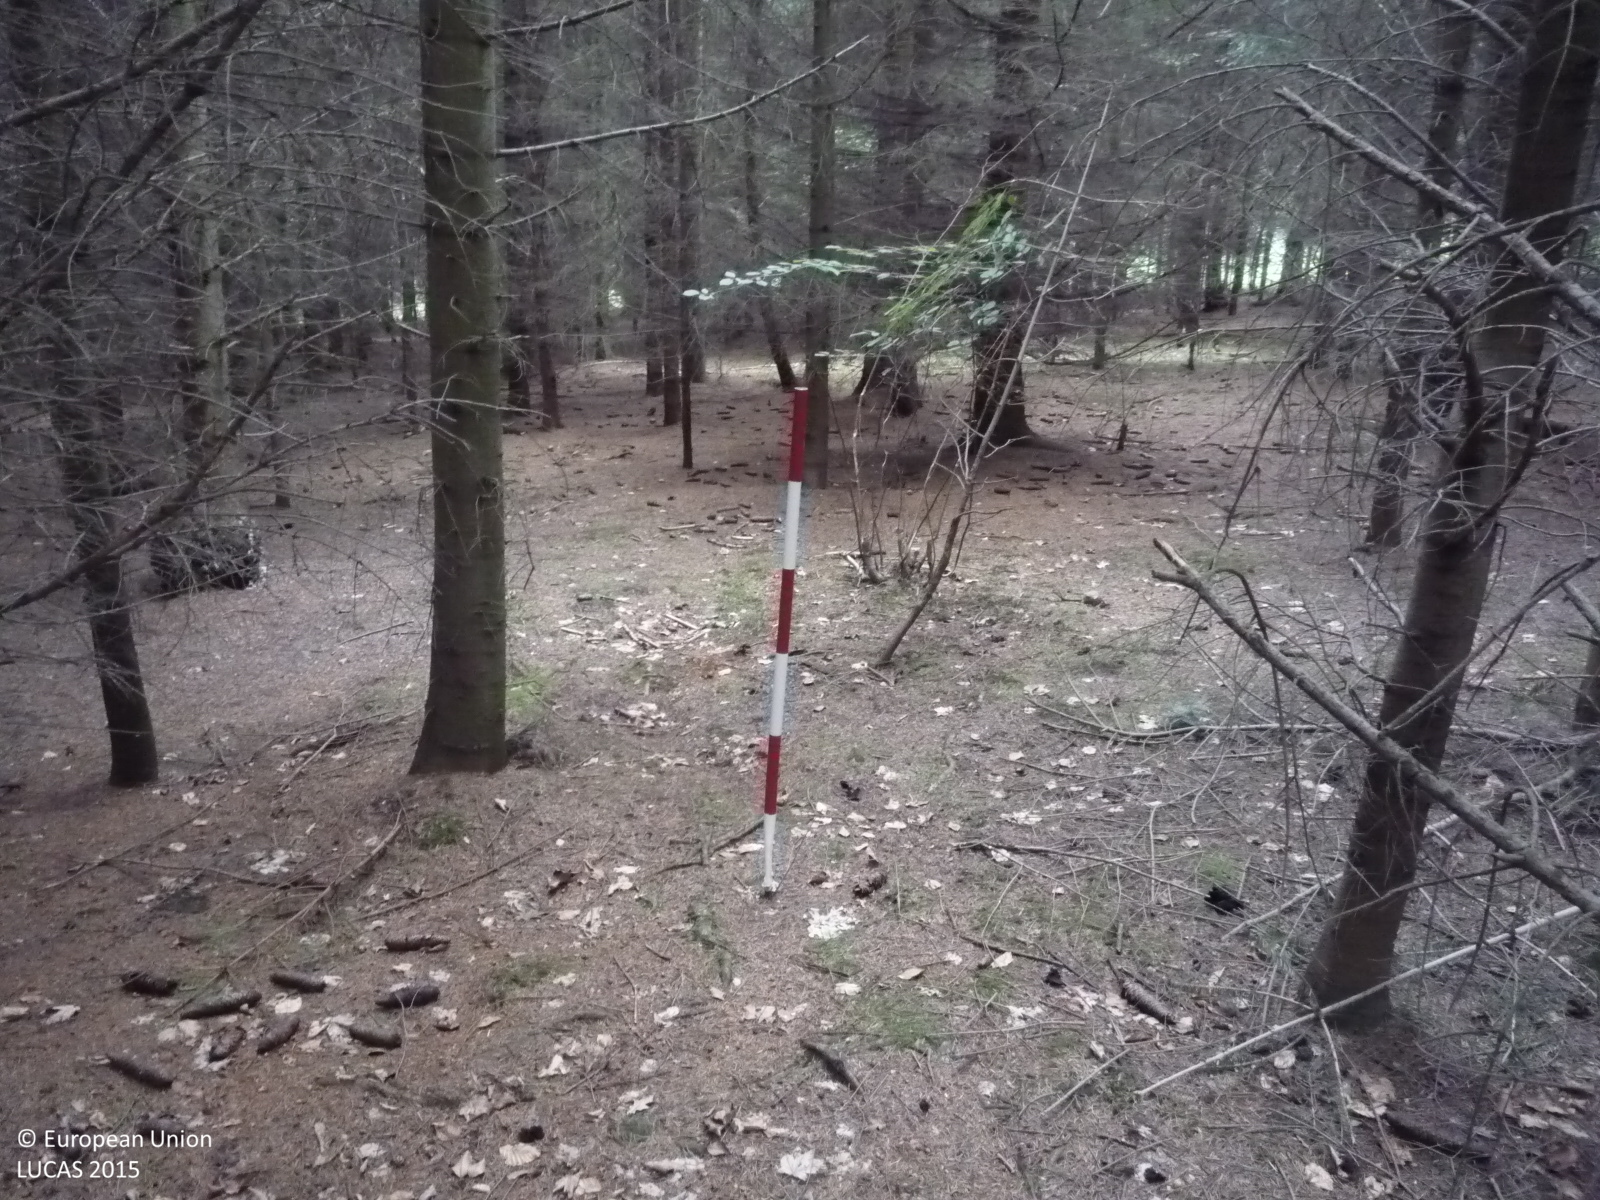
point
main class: Woodland
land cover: Other coniferous woodland
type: hemiboreal forest and nemoral coniferous forest and mixed broadleaved-coniferous forest
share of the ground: > 75 %
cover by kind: coniferous forest trees 95 %, broadleaved forest trees 5 %
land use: Forestry
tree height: > 5 m
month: June
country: CZ
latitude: 49.7422
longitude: 15.1791
